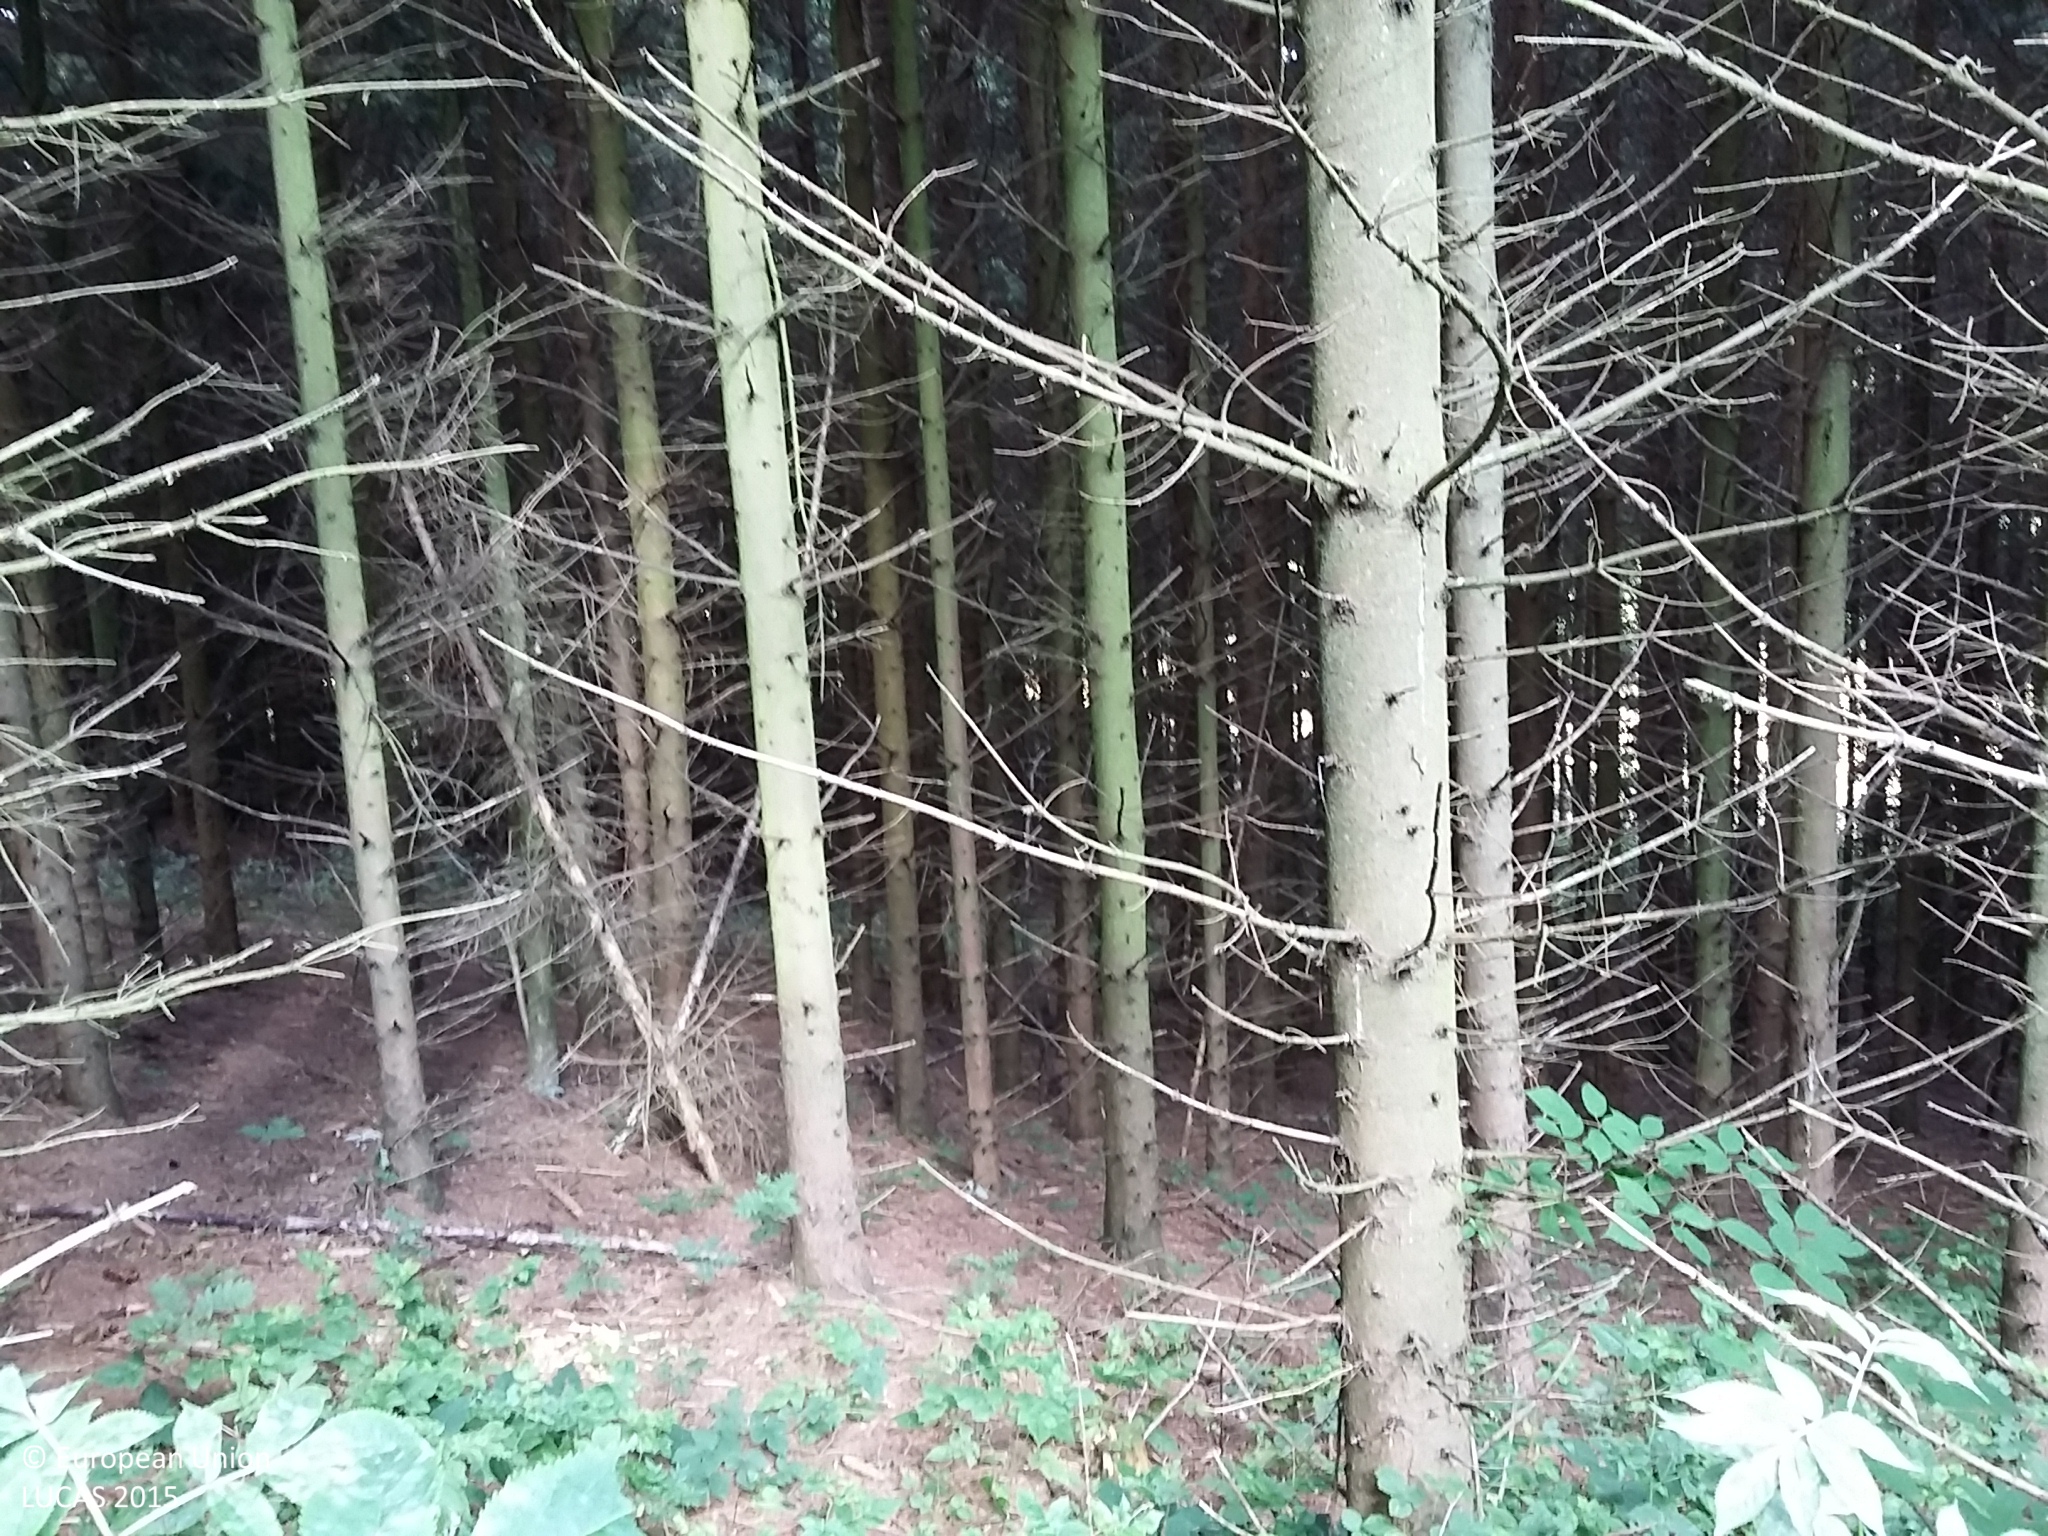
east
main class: Woodland
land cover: Spruce dominated coniferous woodland
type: hemiboreal forest and nemoral coniferous forest and mixed broadleaved-coniferous forest
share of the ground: > 75 %
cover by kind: coniferous forest trees 75 %, broadleaved forest trees 15 %, herbaceous plants 10 %
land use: Forestry
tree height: > 5 m
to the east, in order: Spruce dominated coniferous woodland; Tracks; Spruce dominated coniferous woodland; Grassland without tree/shrub cover; Rivers and streams; Broadleaved woodland; Rape and turnip rape
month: August
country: DK
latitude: 55.1991
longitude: 14.7603
